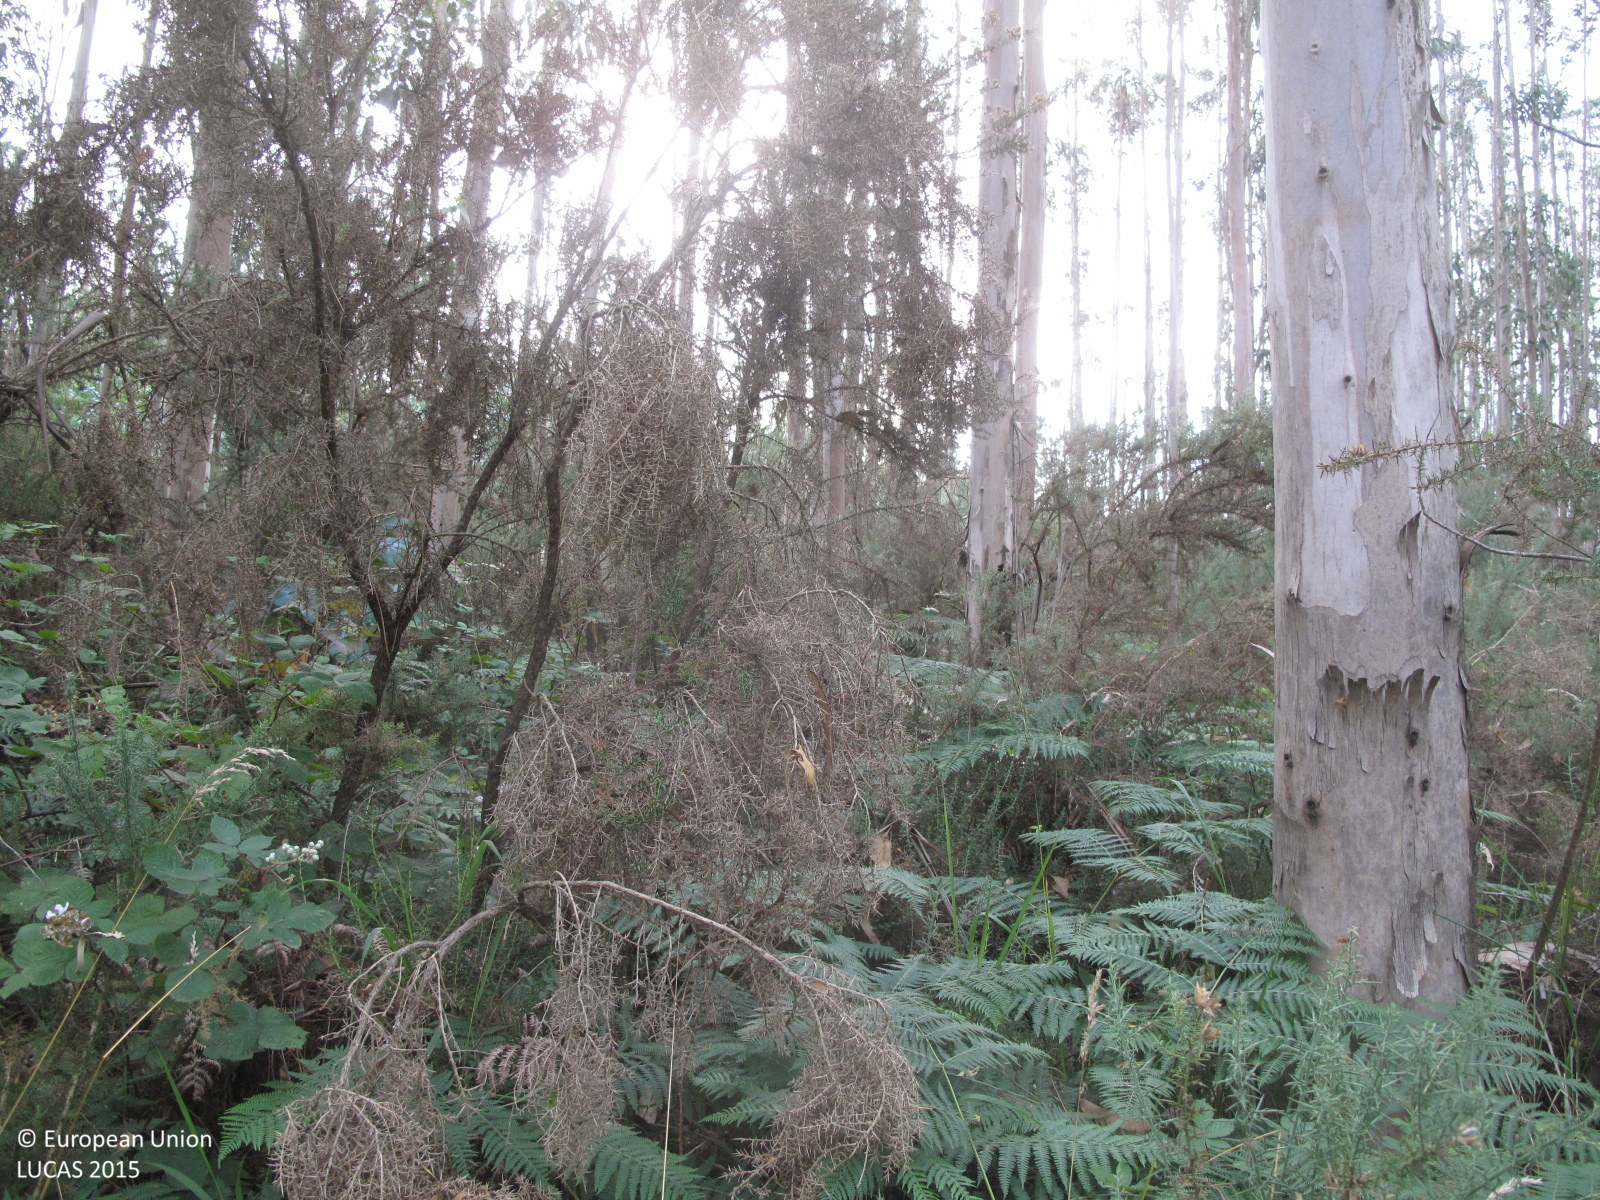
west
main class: Woodland
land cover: Broadleaved woodland
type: exotic forest
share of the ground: 25 - 50 %
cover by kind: shrubs 50 %, broadleaved forest trees 30 %, herbaceous plants 20 %
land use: Forestry
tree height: > 5 m
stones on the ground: < 10 %
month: July
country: ES
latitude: 43.1459
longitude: -8.7175
